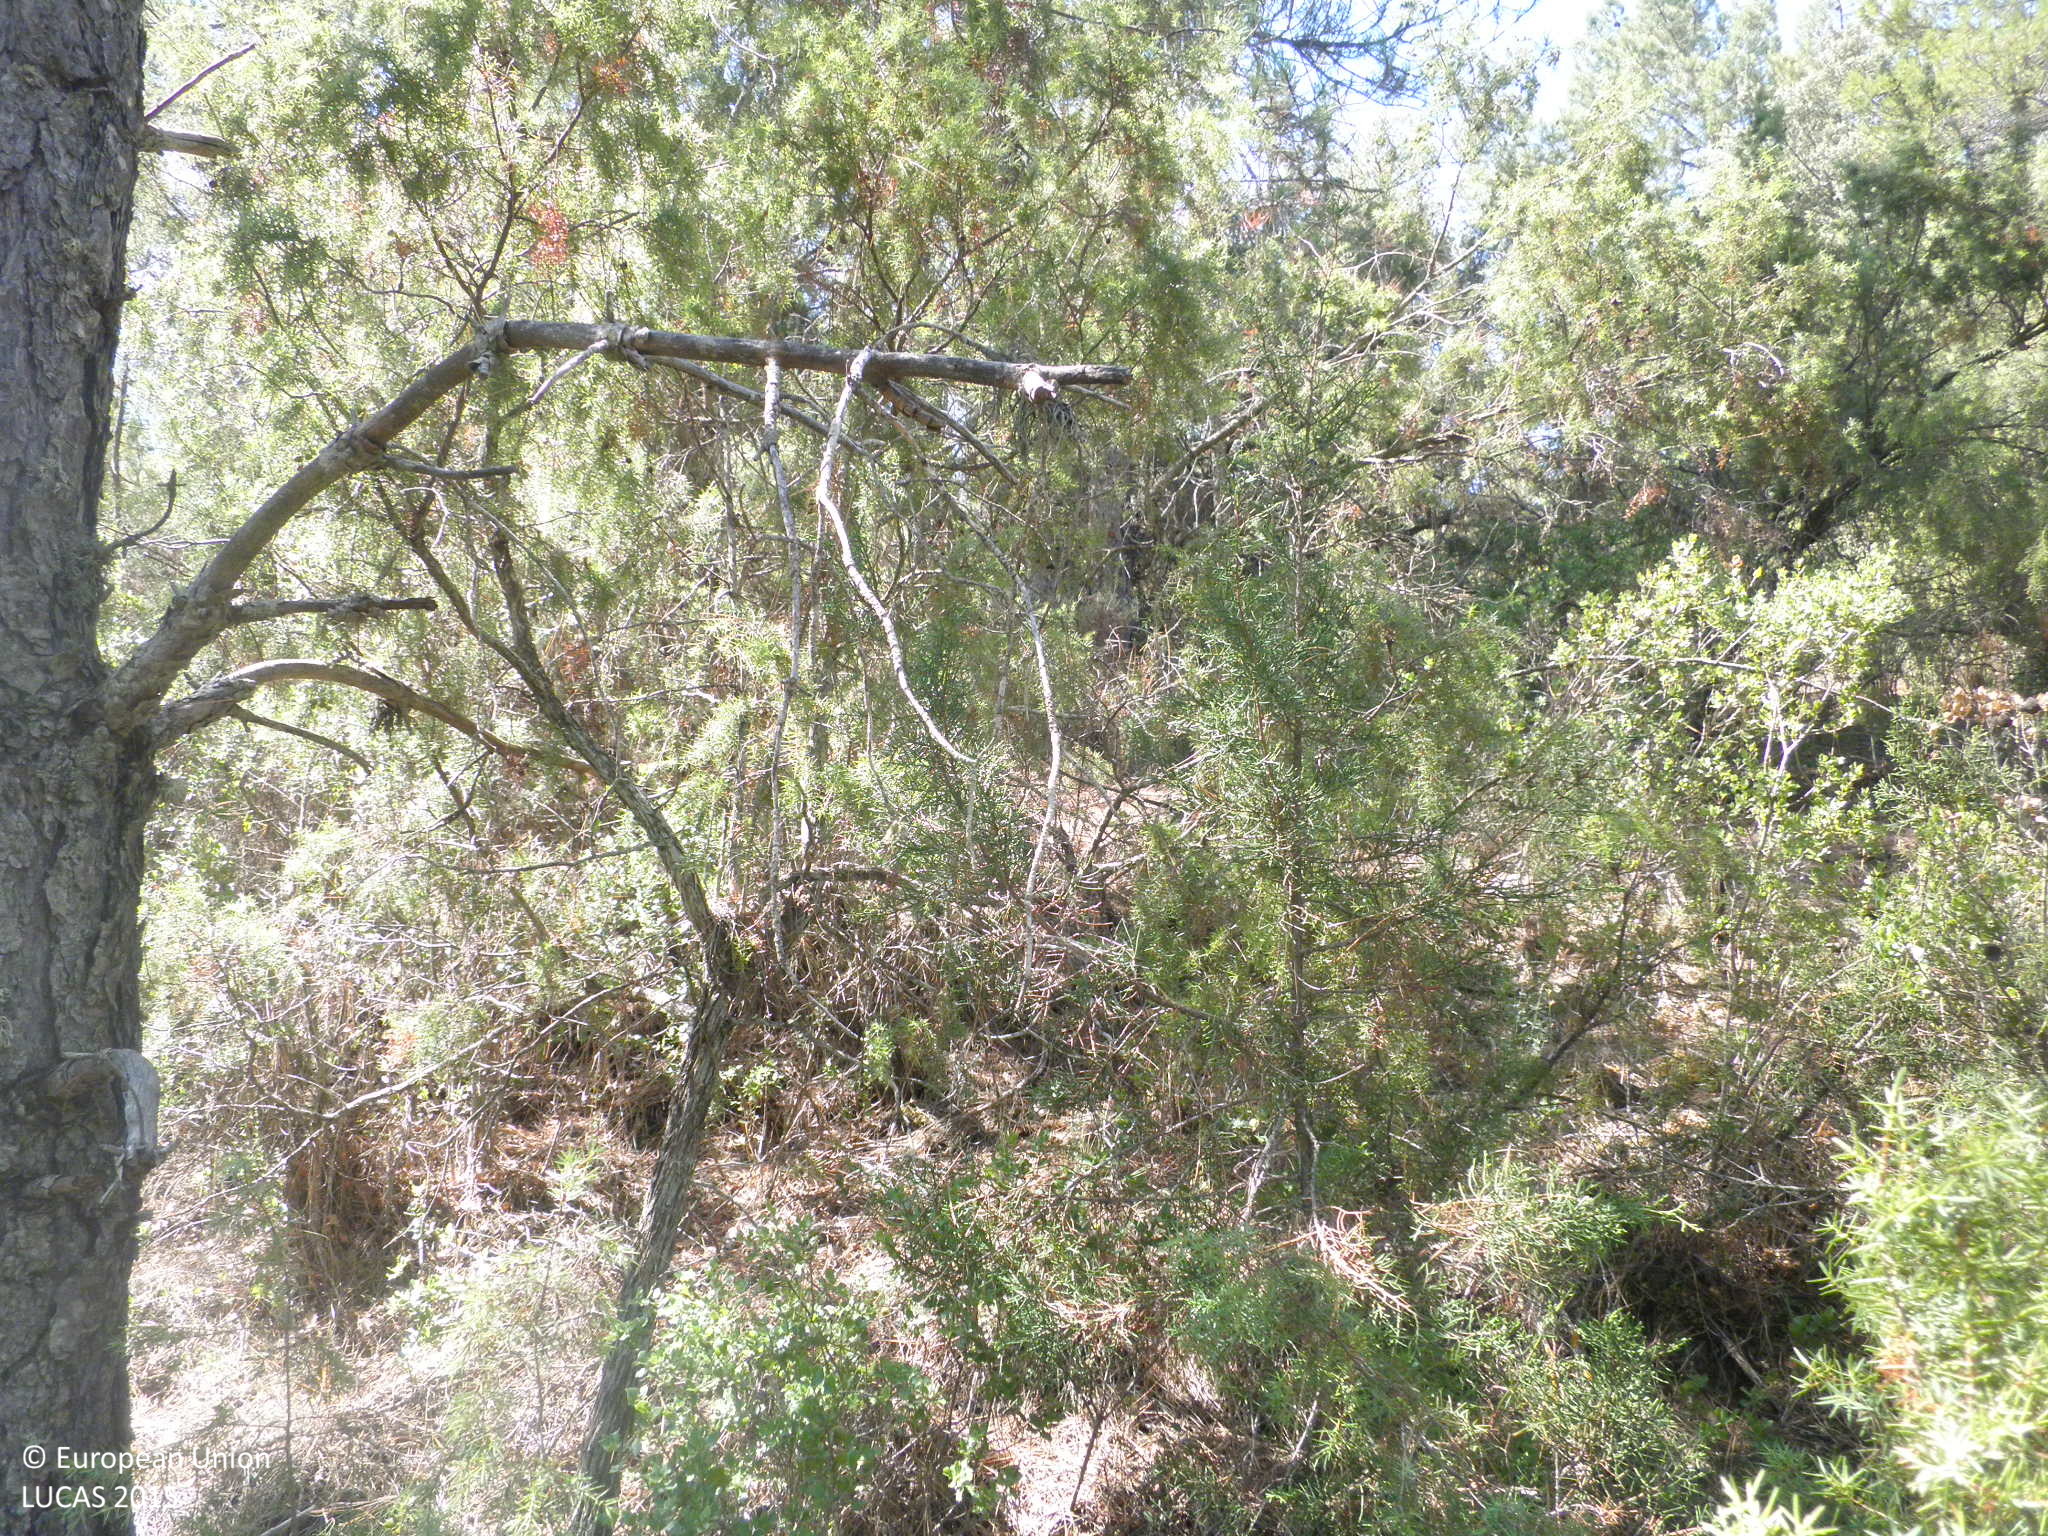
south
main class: Woodland
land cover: Pine dominated coniferous woodland
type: coniferous forest of the mediterranean region
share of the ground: 50 - 75 %
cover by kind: coniferous forest trees 60 %, unconsolidated bare surface 20 %, shrubs 15 %, herbaceous plants 5 %
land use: Semi-natural and natural areas not in use
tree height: > 5 m
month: July
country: ES
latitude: 39.6866
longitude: -1.7498
